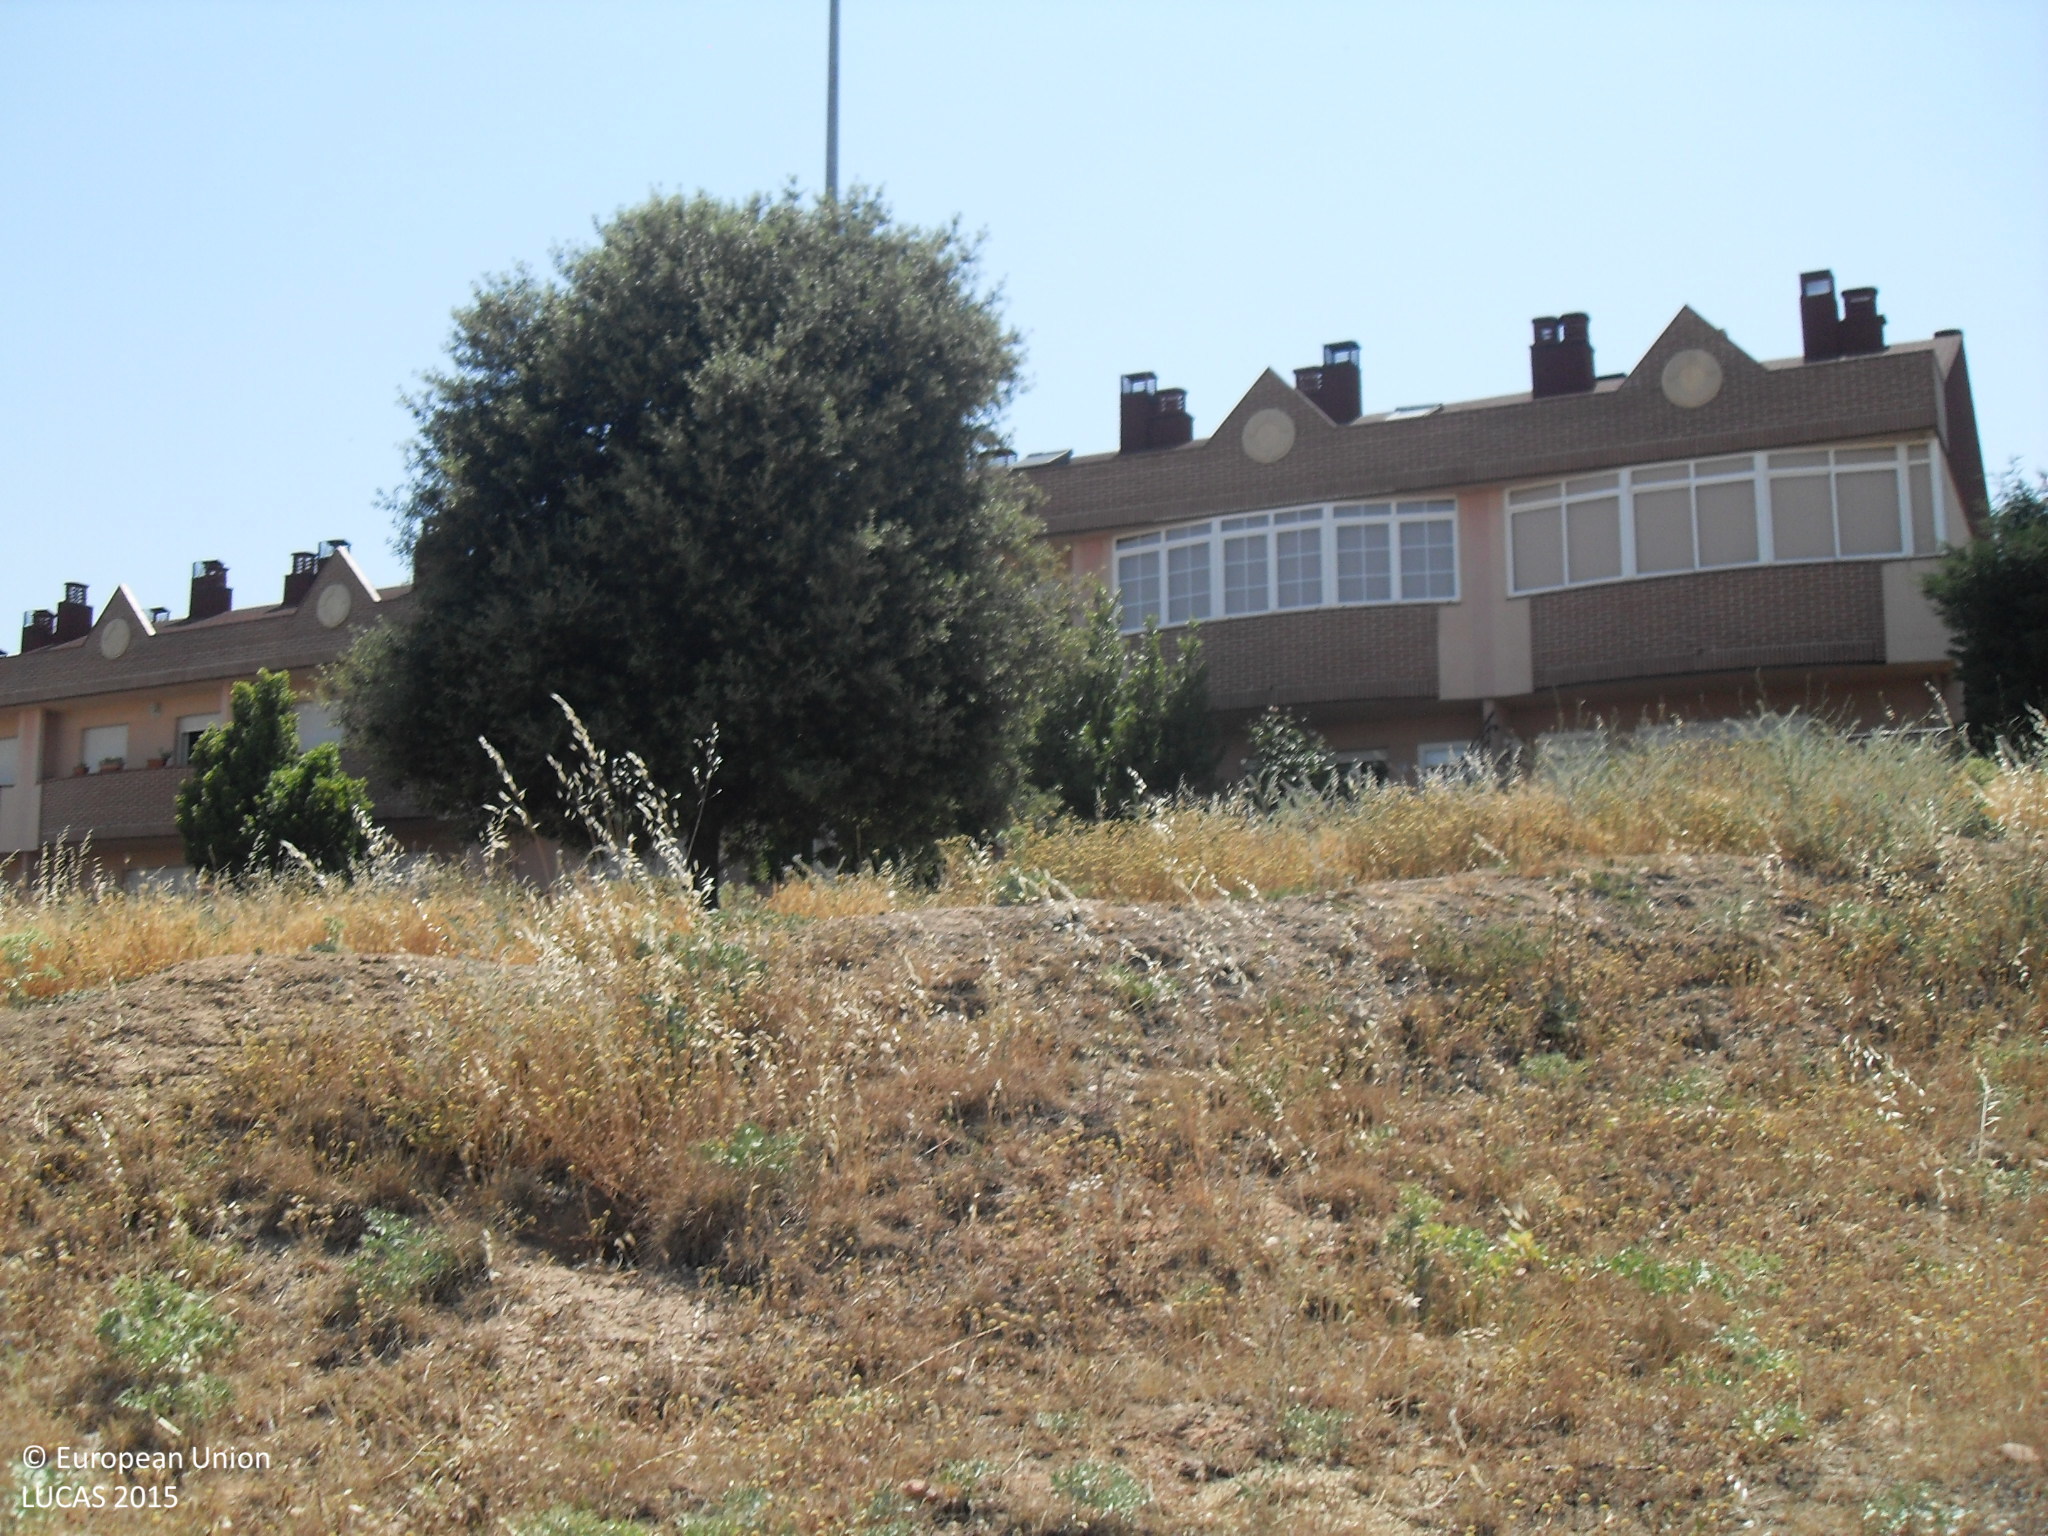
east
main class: Grassland
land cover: Grassland with sparse tree/shrub cover
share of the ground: > 75 %
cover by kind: herbaceous plants 95 %, coniferous forest trees 5 %
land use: Semi-natural and natural areas not in use
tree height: > 5 m
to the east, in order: Grassland with sparse tree/shrub cover; Artificial constructions in urban areas
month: June
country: ES
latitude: 40.9473
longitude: -5.6743
